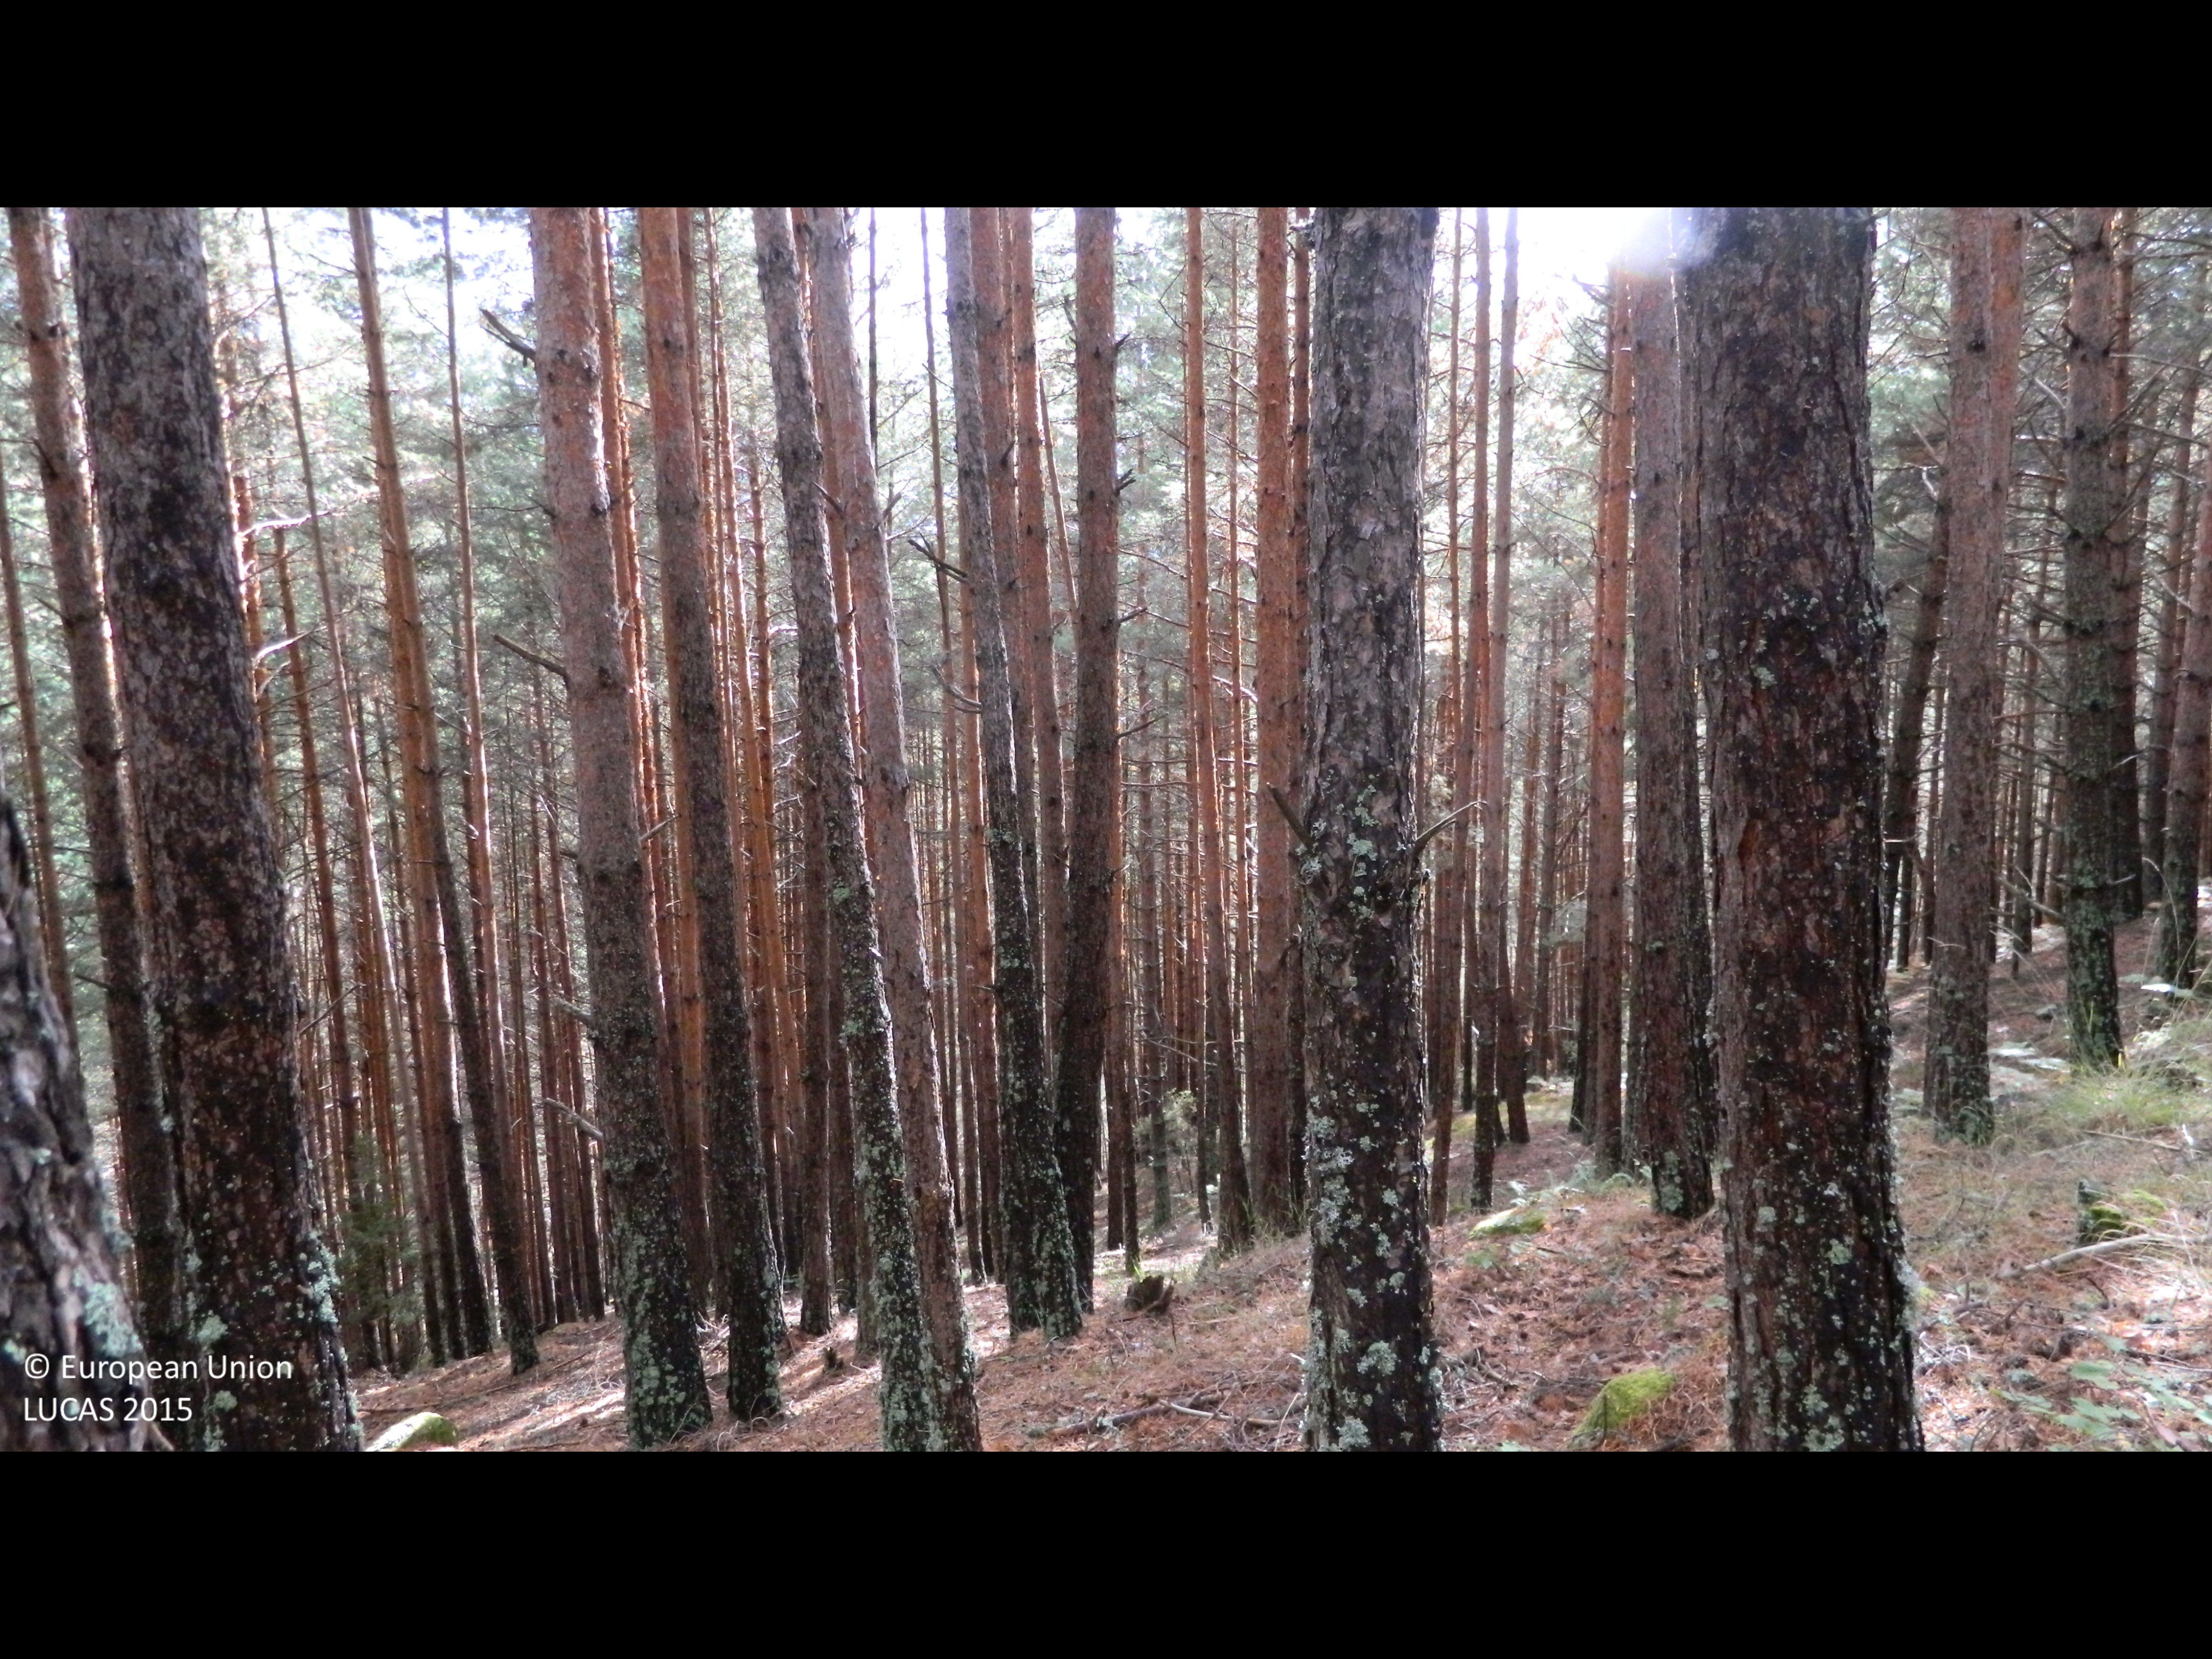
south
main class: Woodland
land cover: Pine dominated coniferous woodland
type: hemiboreal forest and nemoral coniferous forest and mixed broadleaved-coniferous forest
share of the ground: > 75 %
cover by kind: coniferous forest trees 100 %
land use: Forestry
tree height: > 5 m
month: September
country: BG
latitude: 41.6269
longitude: 24.0897
